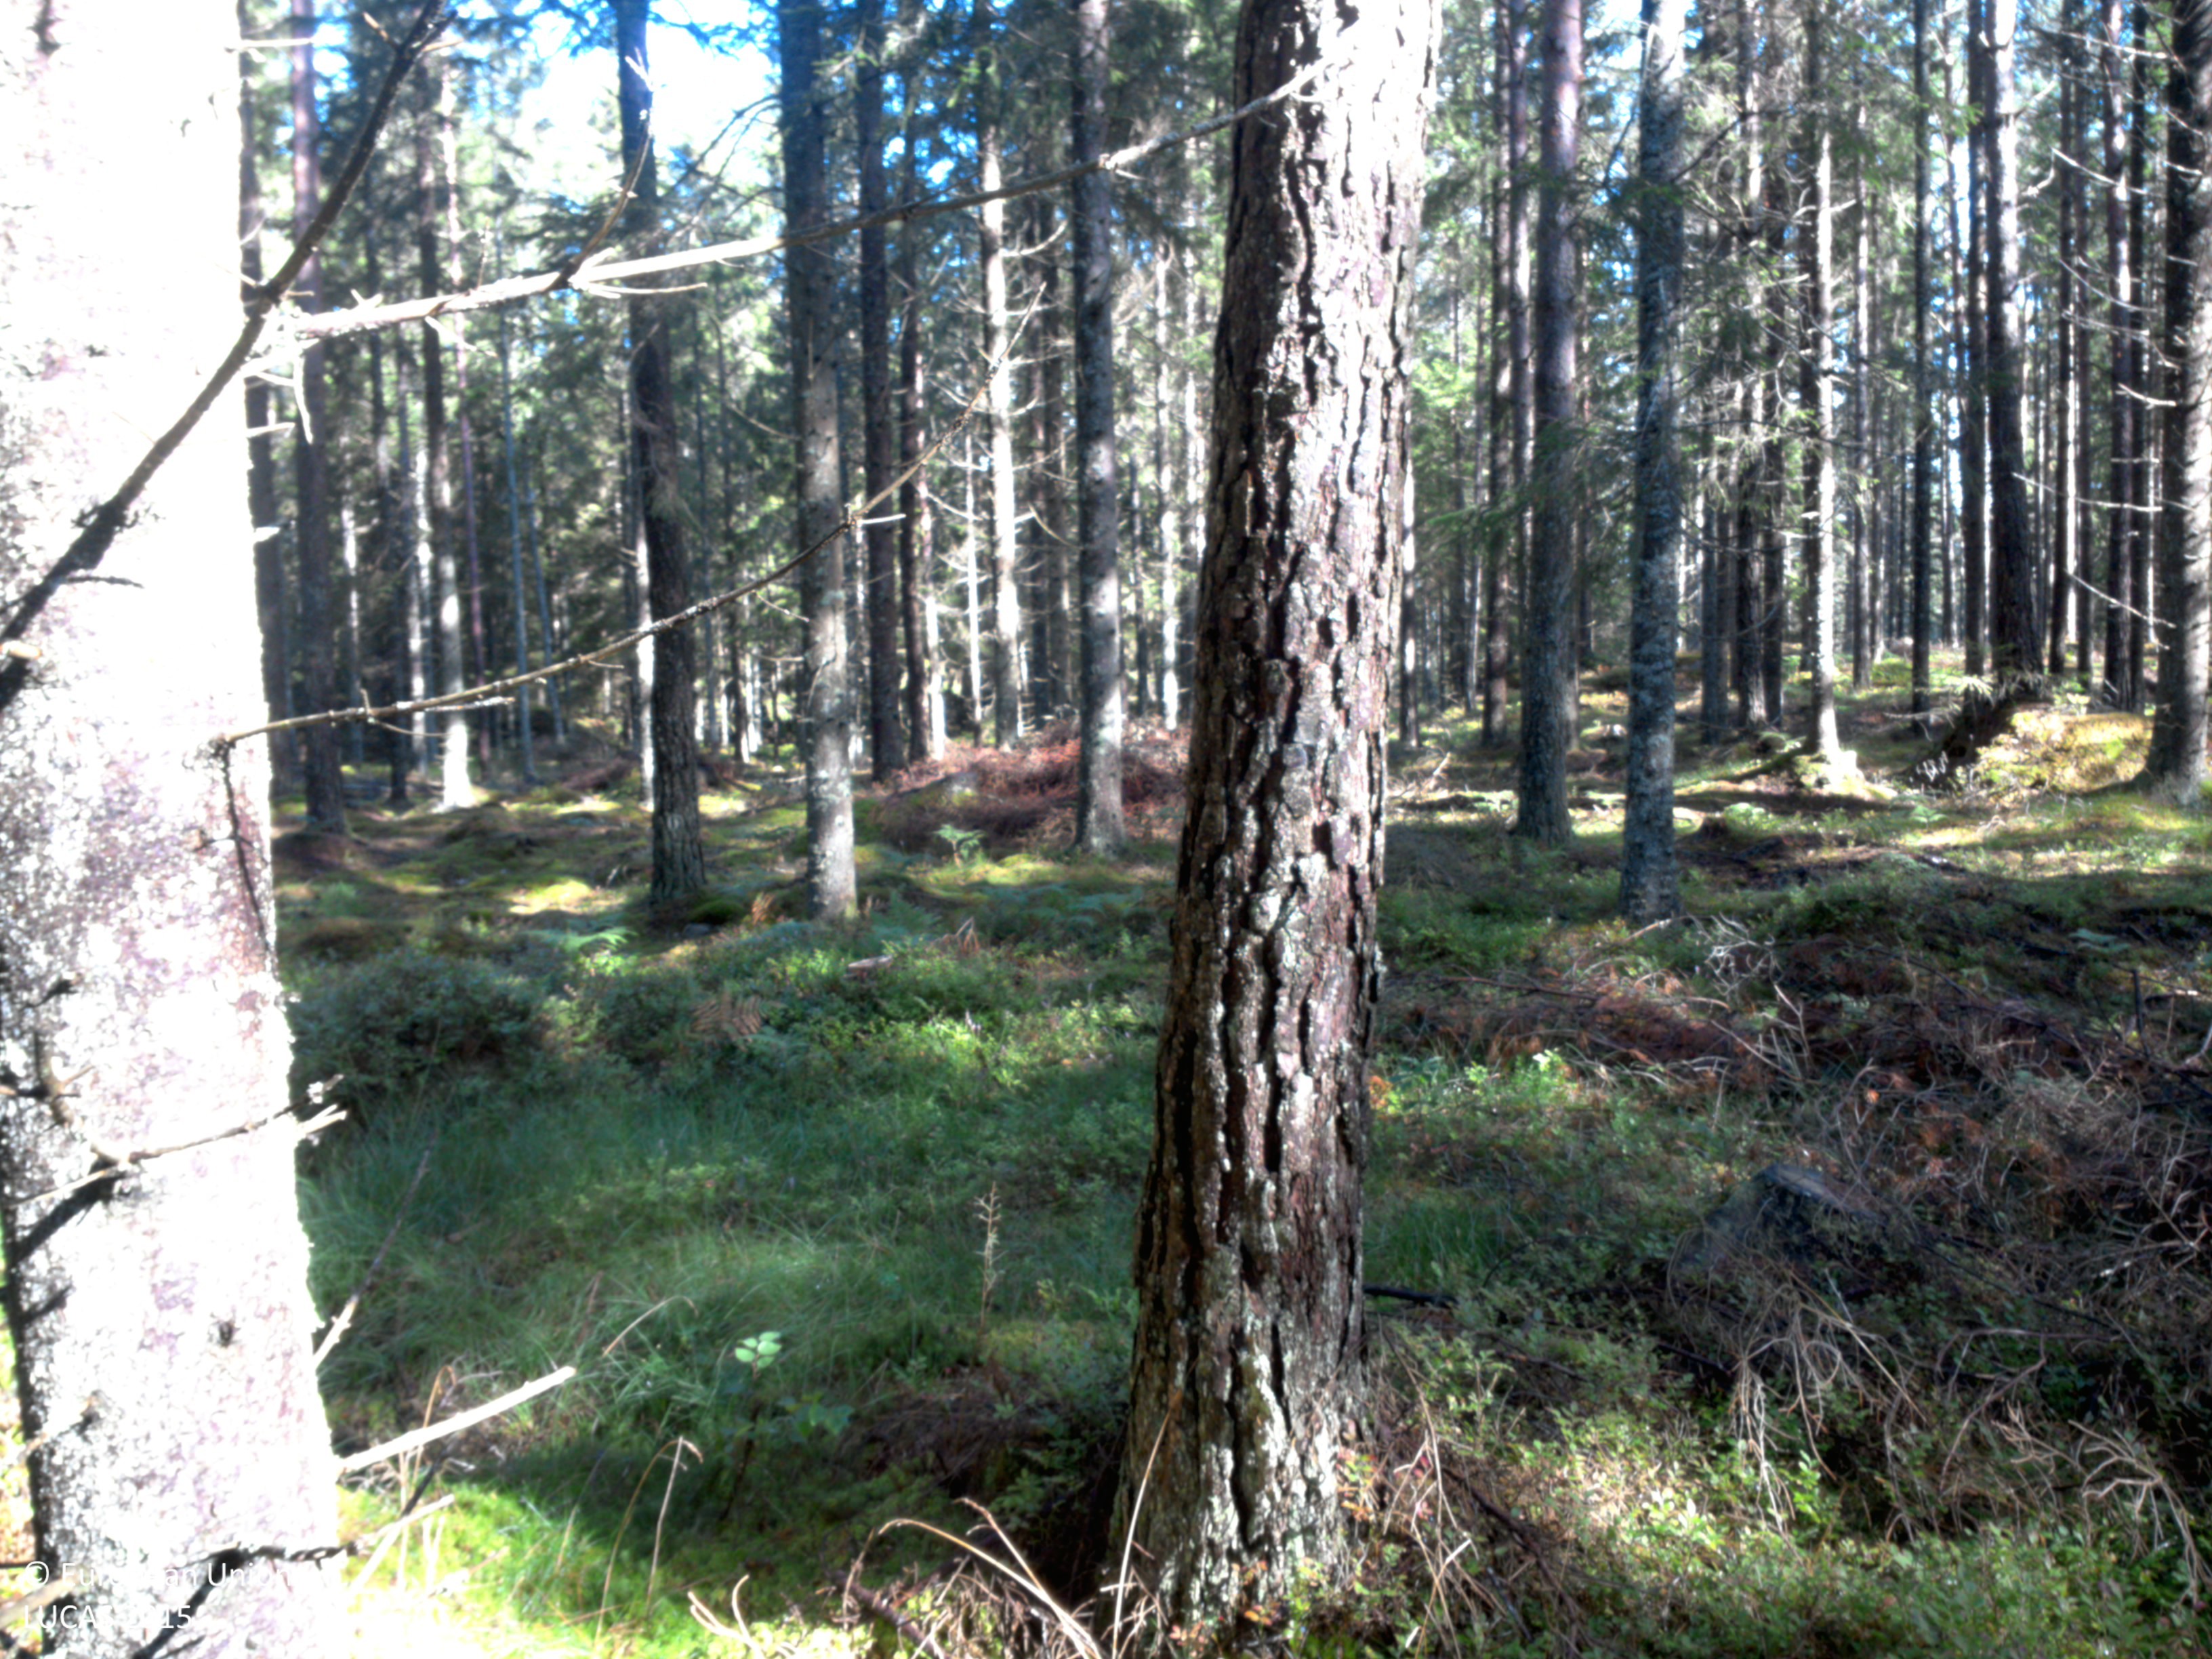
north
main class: Woodland
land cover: Spruce dominated coniferous woodland
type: boreal forest
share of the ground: 50 - 75 %
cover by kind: coniferous forest trees 60 %, lichens and mosses 25 %, shrubs 15 %
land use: Forestry
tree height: > 5 m
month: August
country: SE
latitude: 58.3089
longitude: 12.2314
